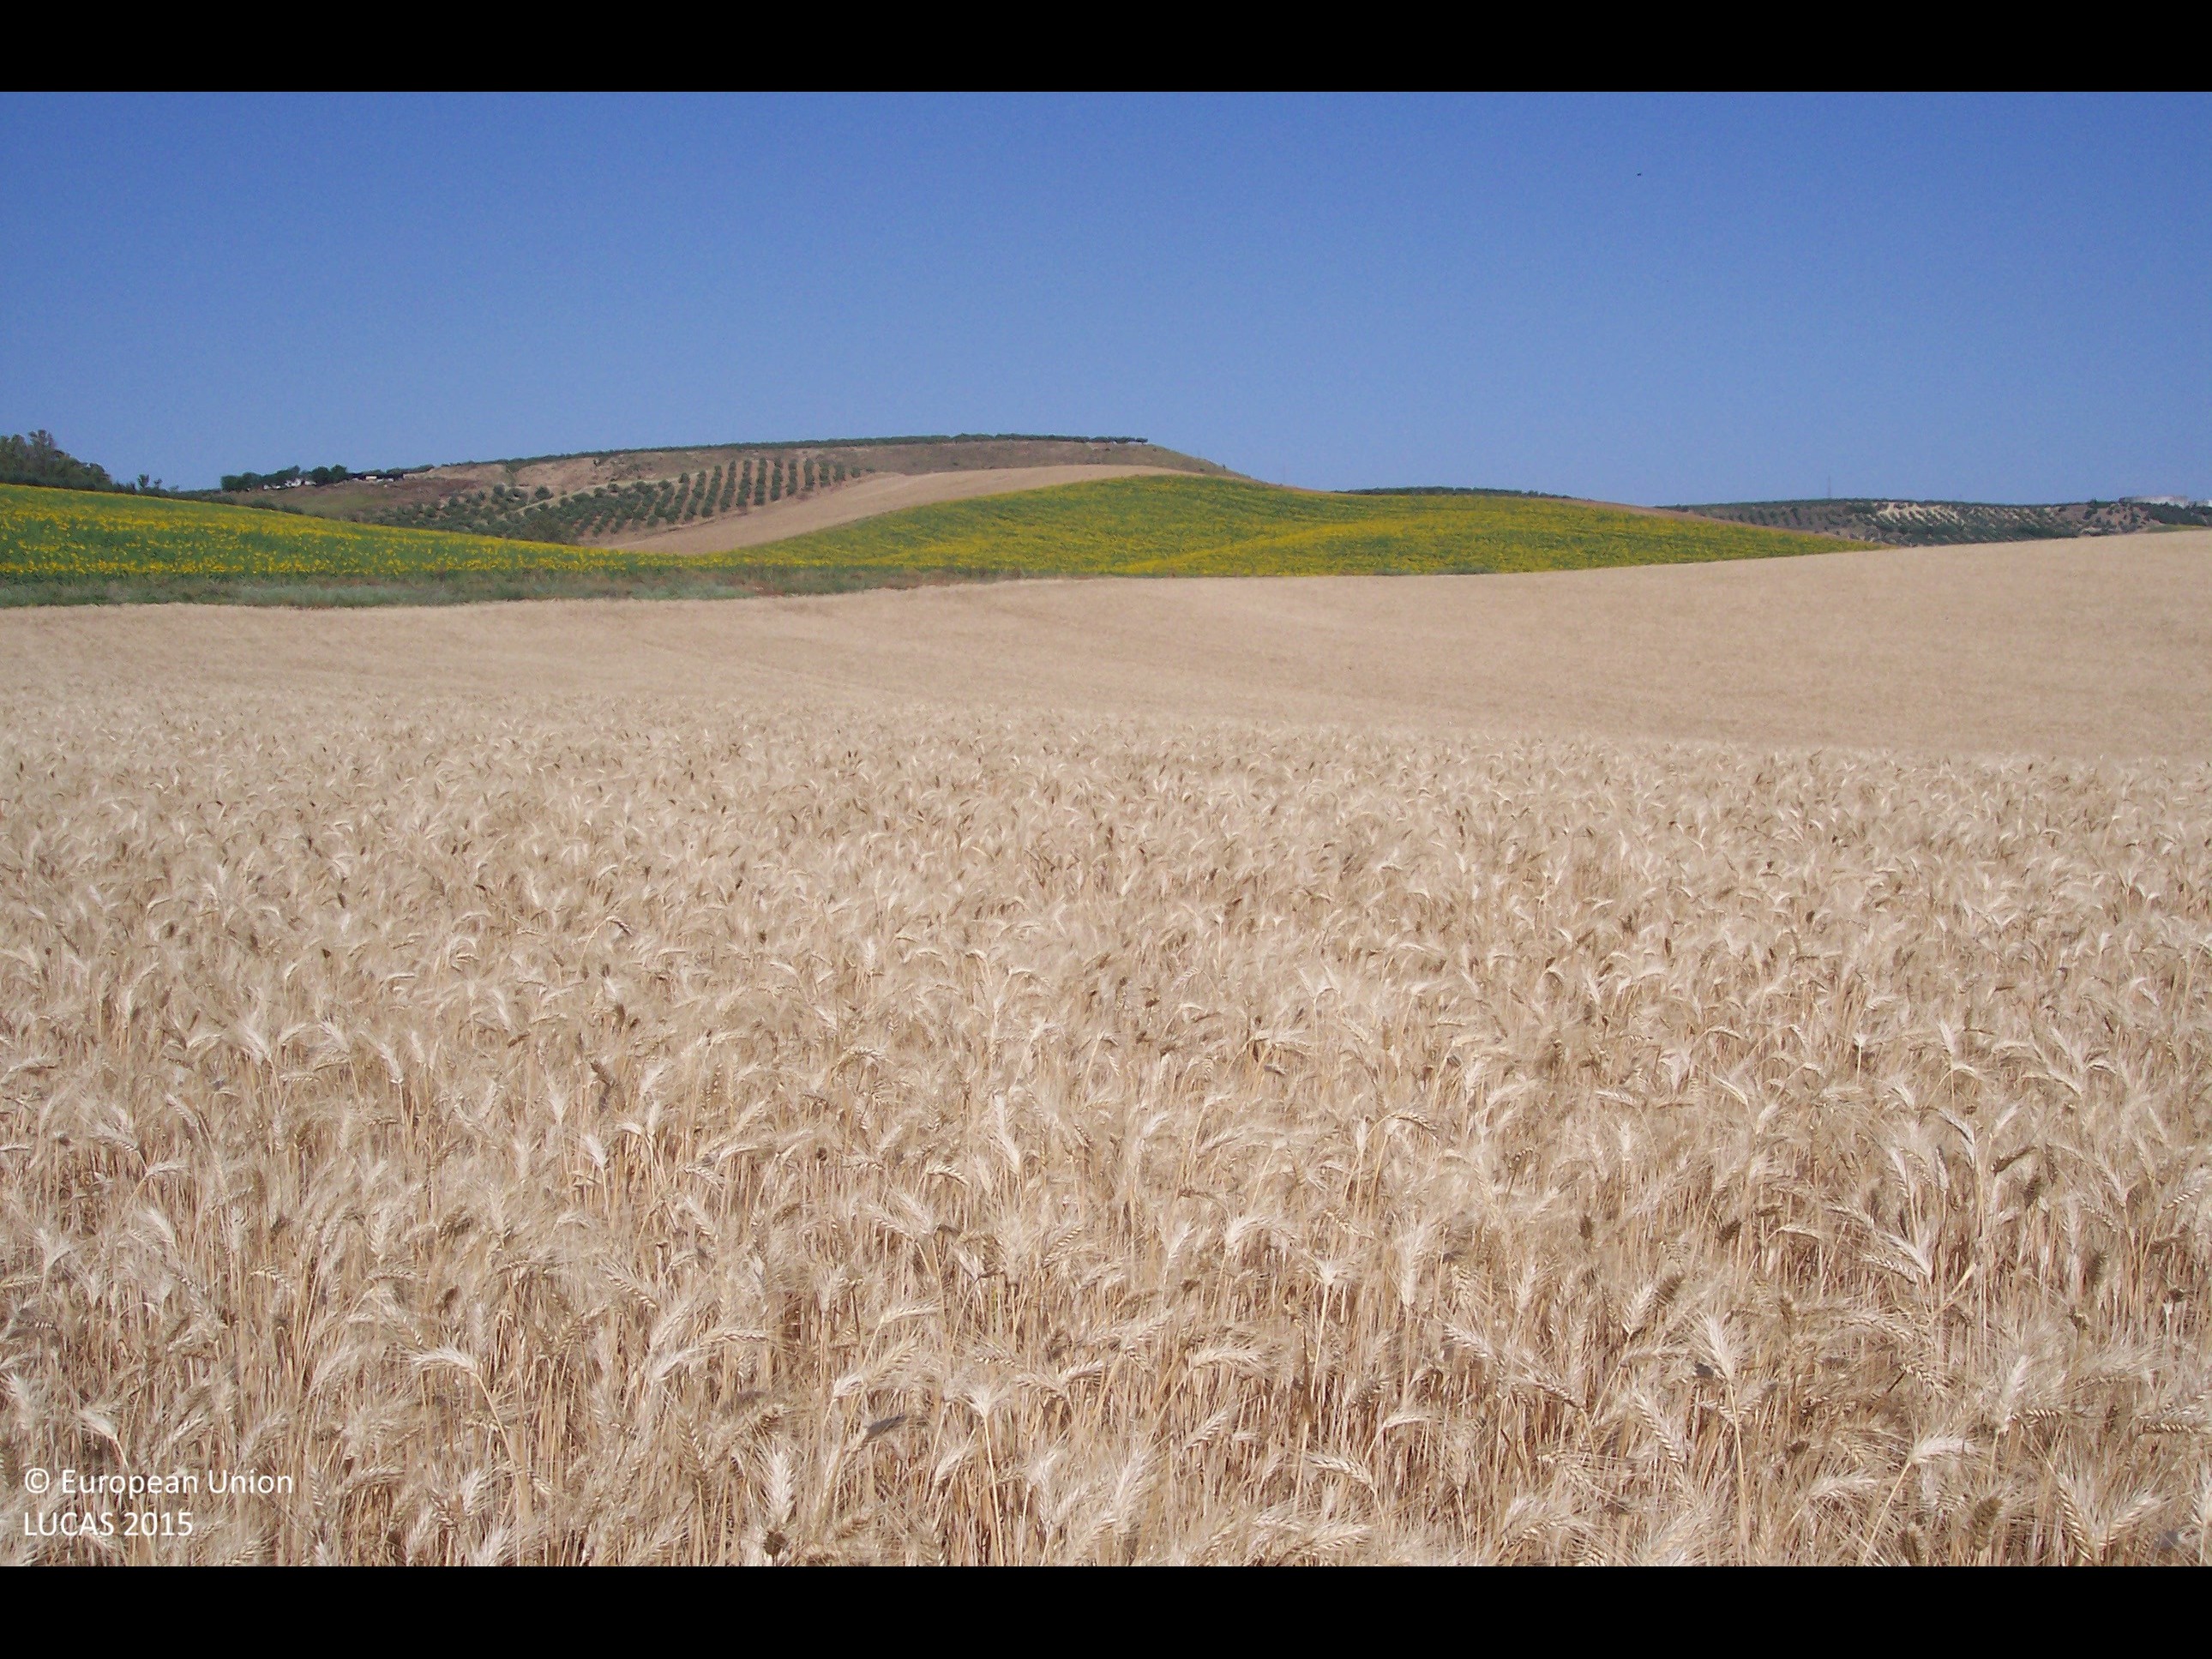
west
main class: Cropland
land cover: Common wheat
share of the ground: > 75 %
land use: Agriculture (excluding fallow land and kitchen gardens)
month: May
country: ES
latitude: 37.4341
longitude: -6.1087
